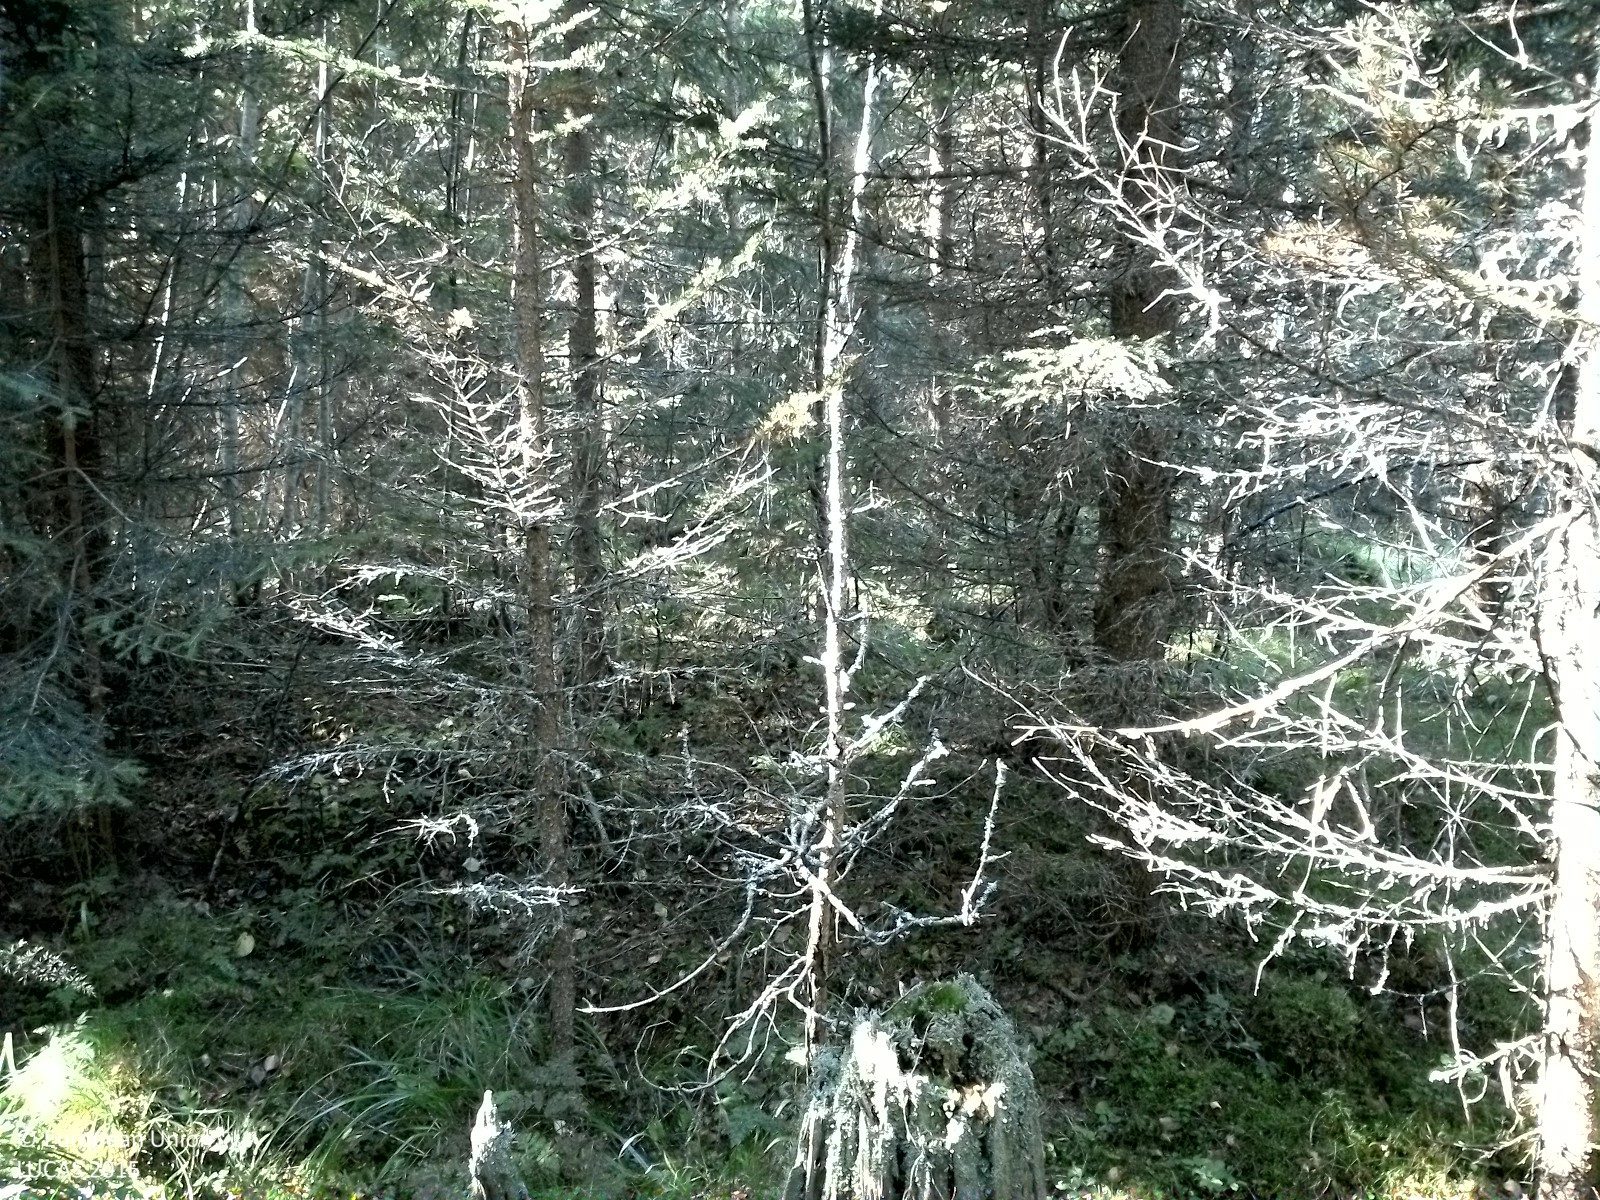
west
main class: Woodland
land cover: Spruce dominated mixed woodland
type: boreal forest
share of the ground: > 75 %
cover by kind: coniferous forest trees 45 %, broadleaved forest trees 25 %, herbaceous plants 15 %, lichens and mosses 15 %
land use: Forestry
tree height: > 5 m
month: September
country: SE
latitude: 62.5334
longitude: 16.3340
